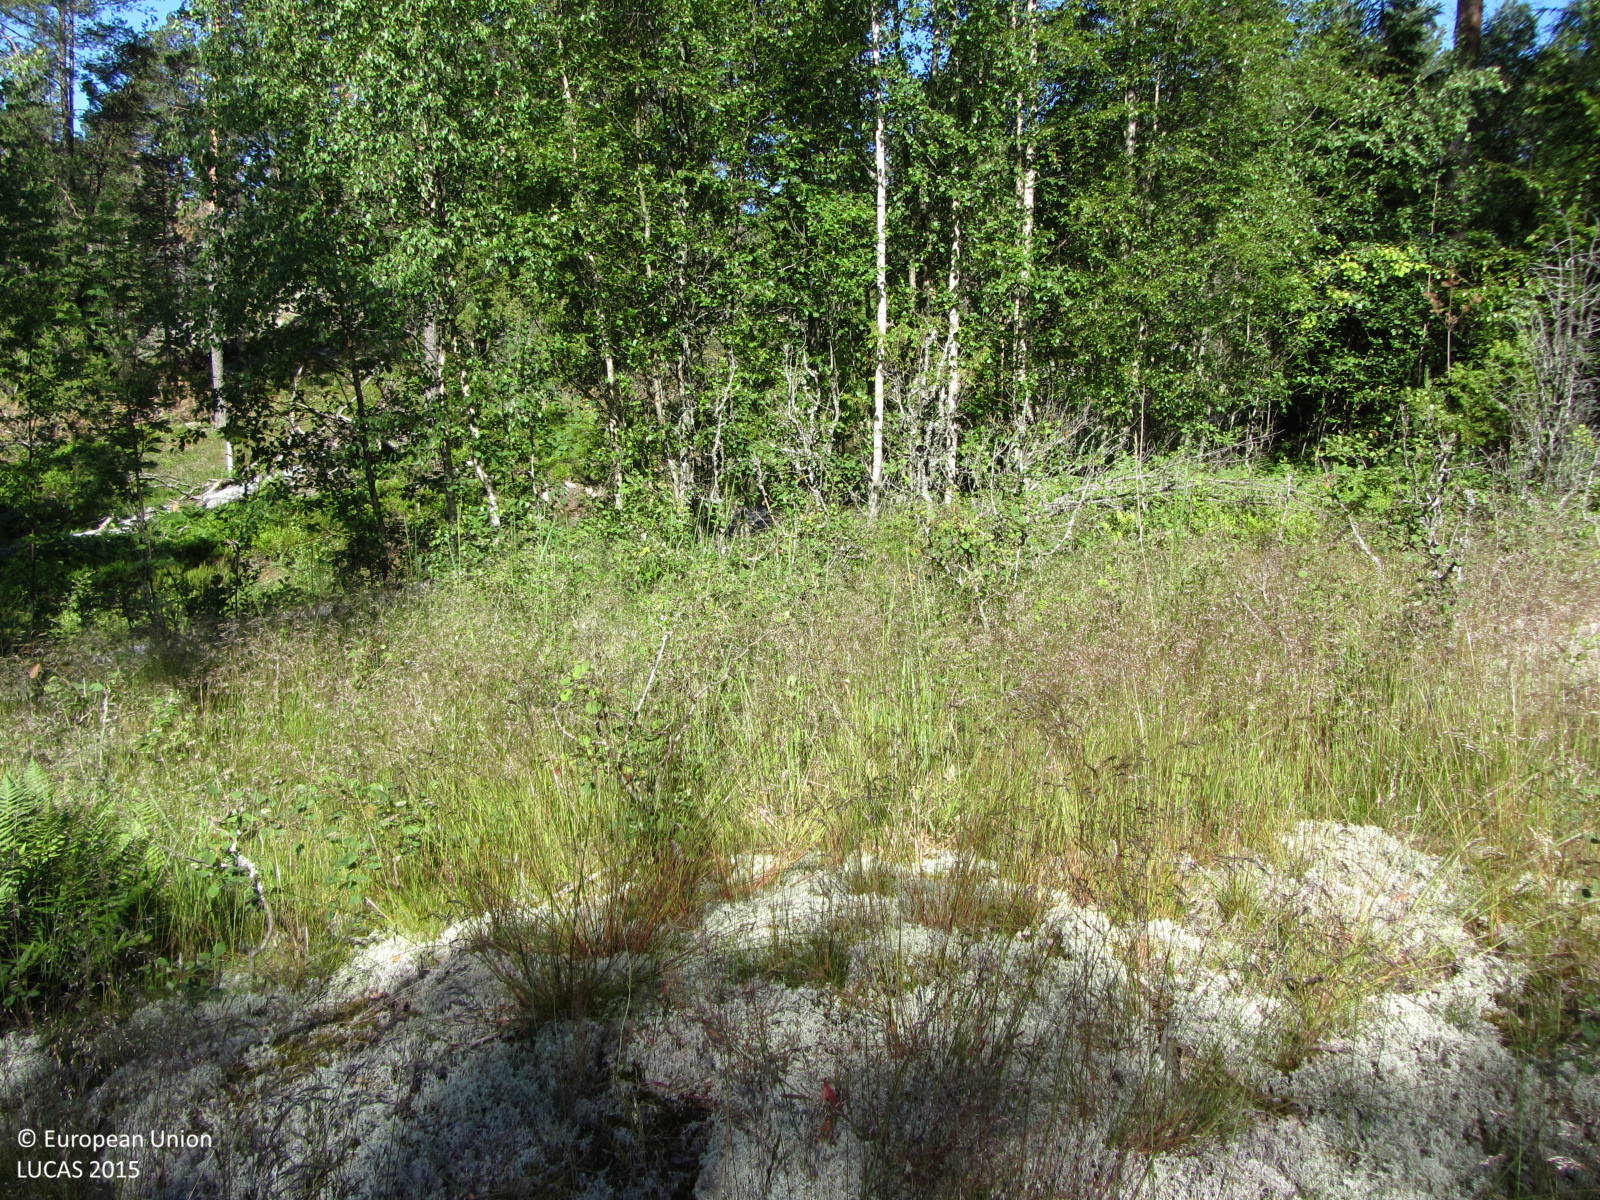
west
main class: Grassland
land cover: Grassland with sparse tree/shrub cover
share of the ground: 50 - 75 %
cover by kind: herbaceous plants 70 %, lichens and mosses 25 %, broadleaved forest trees 5 %
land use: Forestry
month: July
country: FI
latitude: 60.0914
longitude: 23.1546
